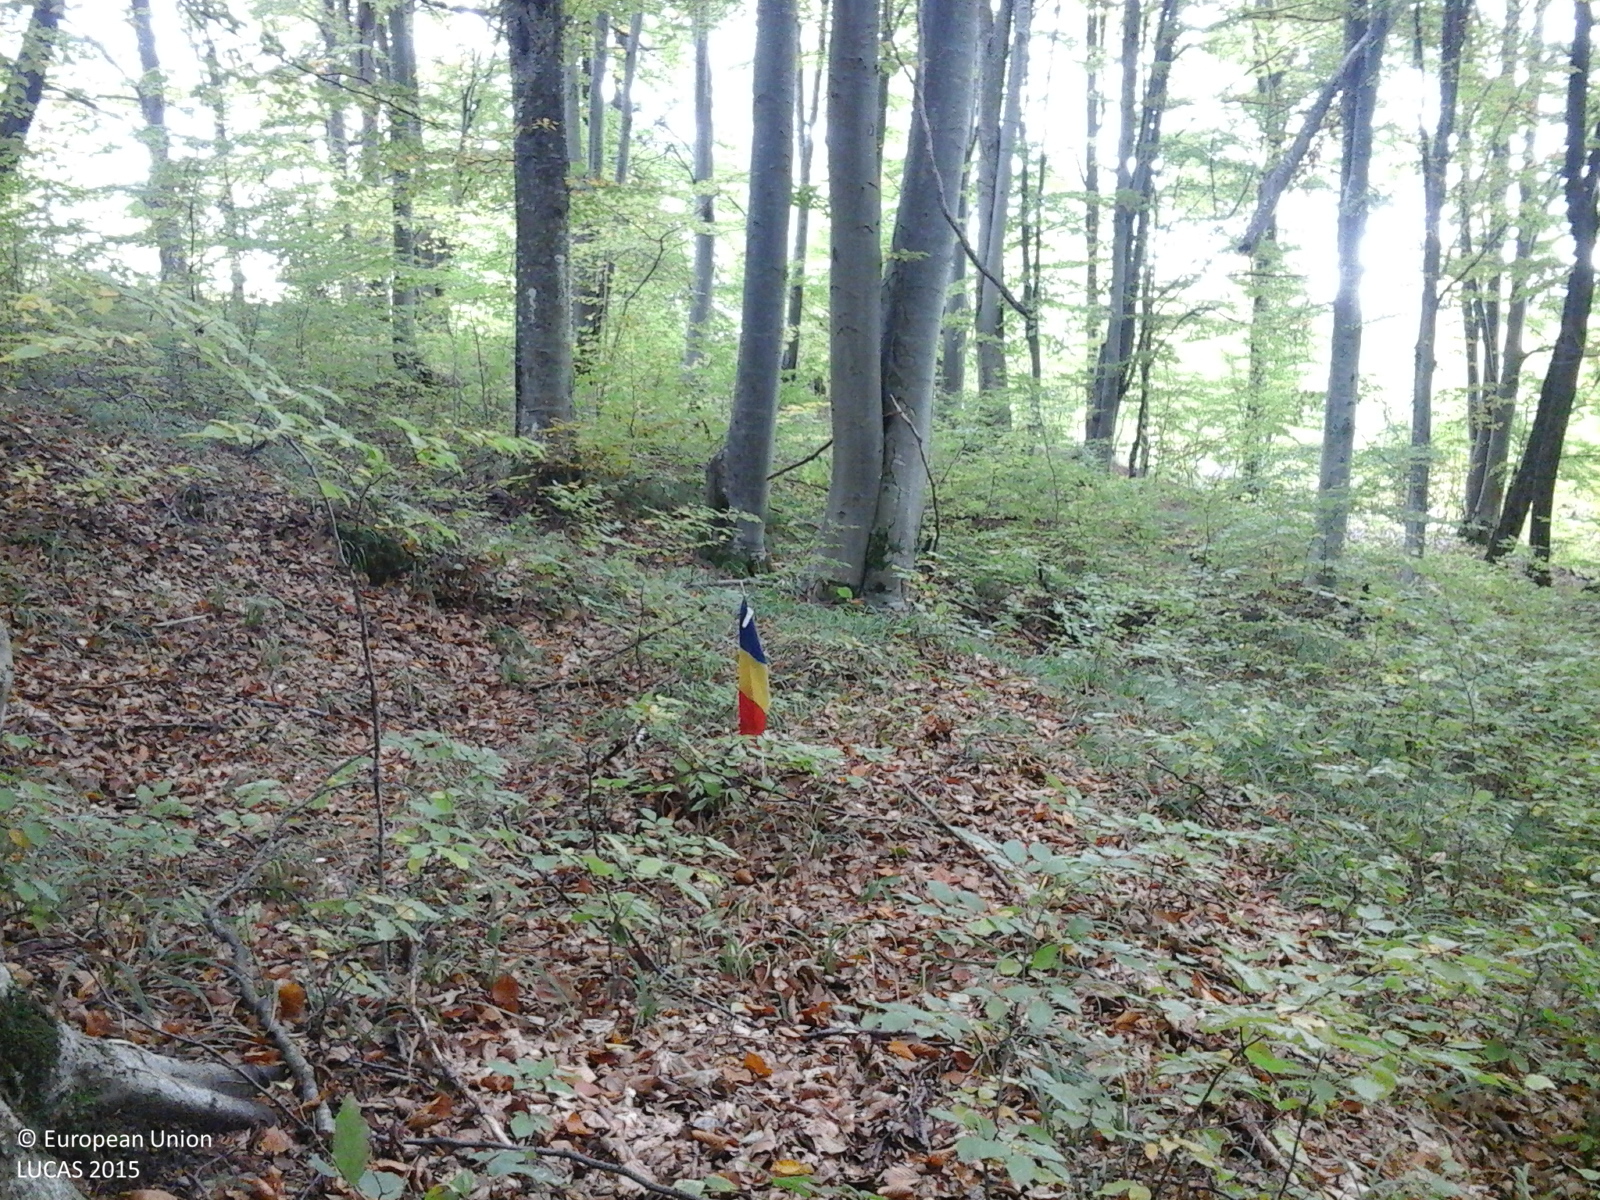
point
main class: Woodland
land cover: Broadleaved woodland
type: beech forest
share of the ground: > 75 %
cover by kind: broadleaved forest trees 100 %
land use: Forestry
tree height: > 5 m
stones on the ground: 10 - 25 %
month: October
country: RO
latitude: 46.6540
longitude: 25.0350
